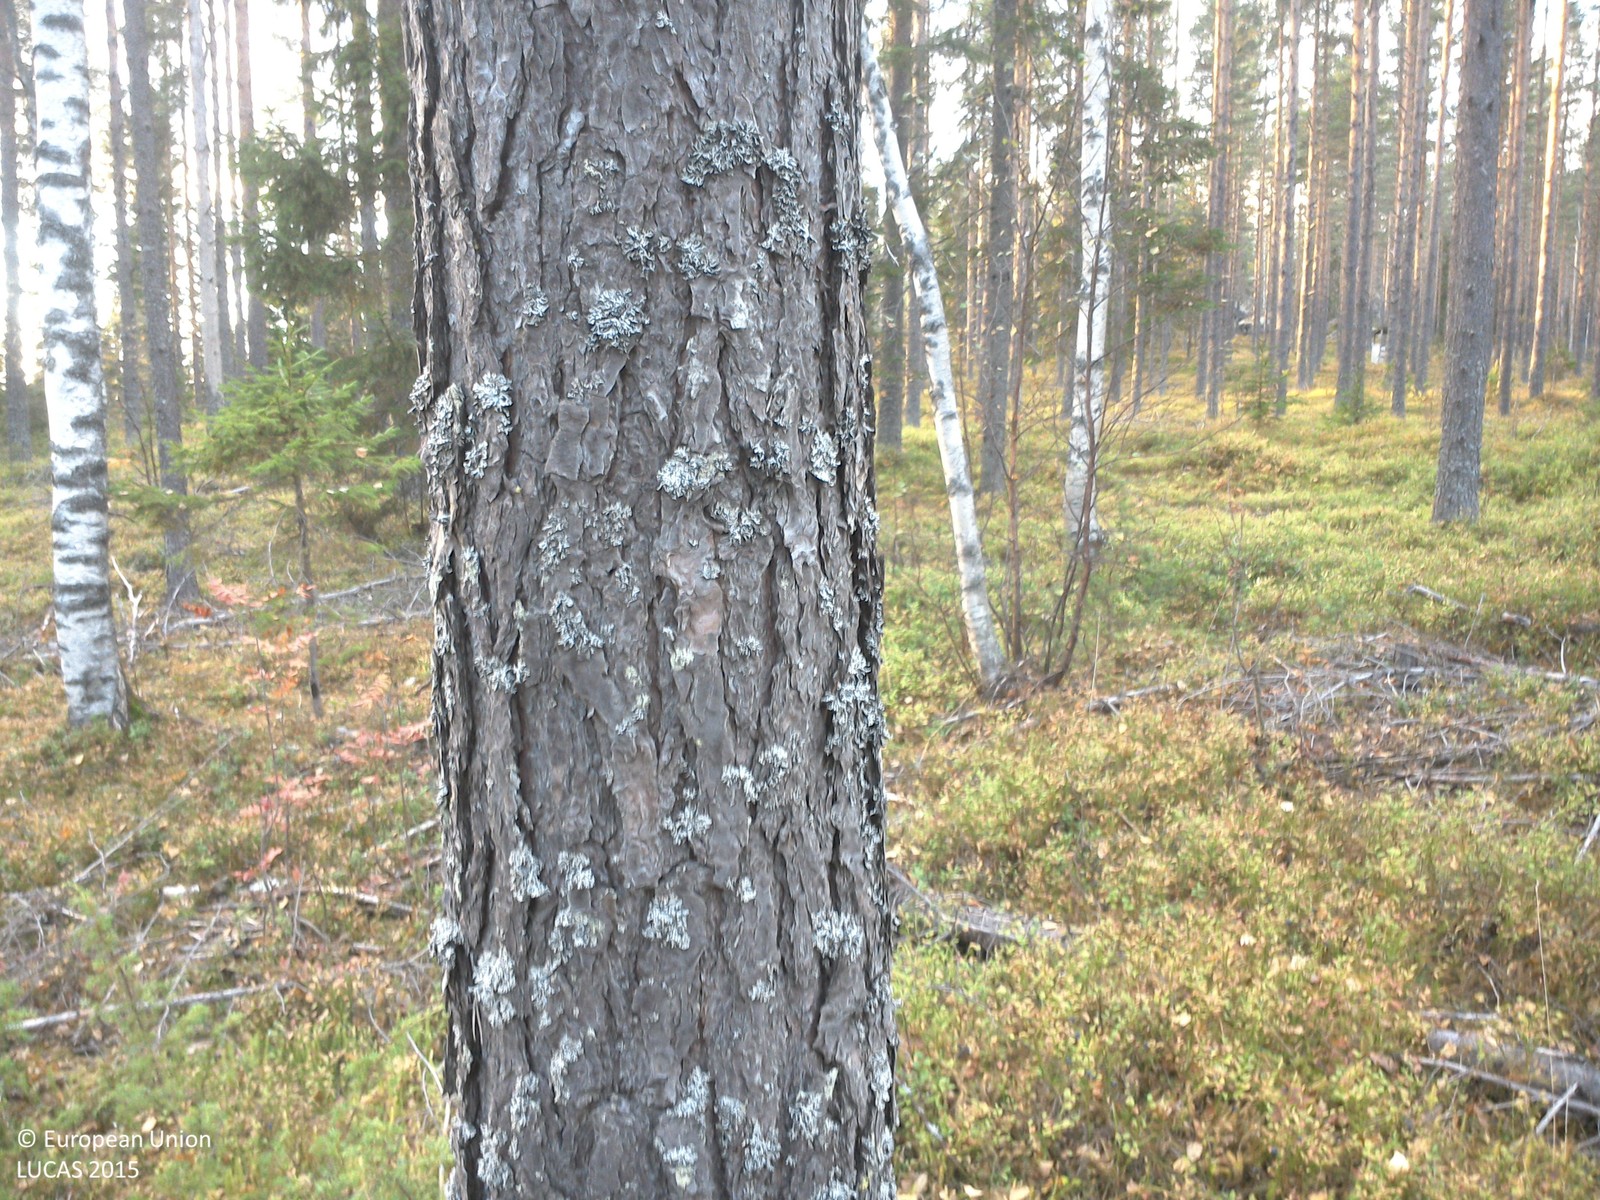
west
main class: Woodland
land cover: Pine dominated mixed woodland
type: boreal forest
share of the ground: 25 - 50 %
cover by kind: shrubs 50 %, coniferous forest trees 30 %, broadleaved forest trees 20 %
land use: Forestry
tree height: > 5 m
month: October
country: SE
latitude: 63.8676
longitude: 19.9304
